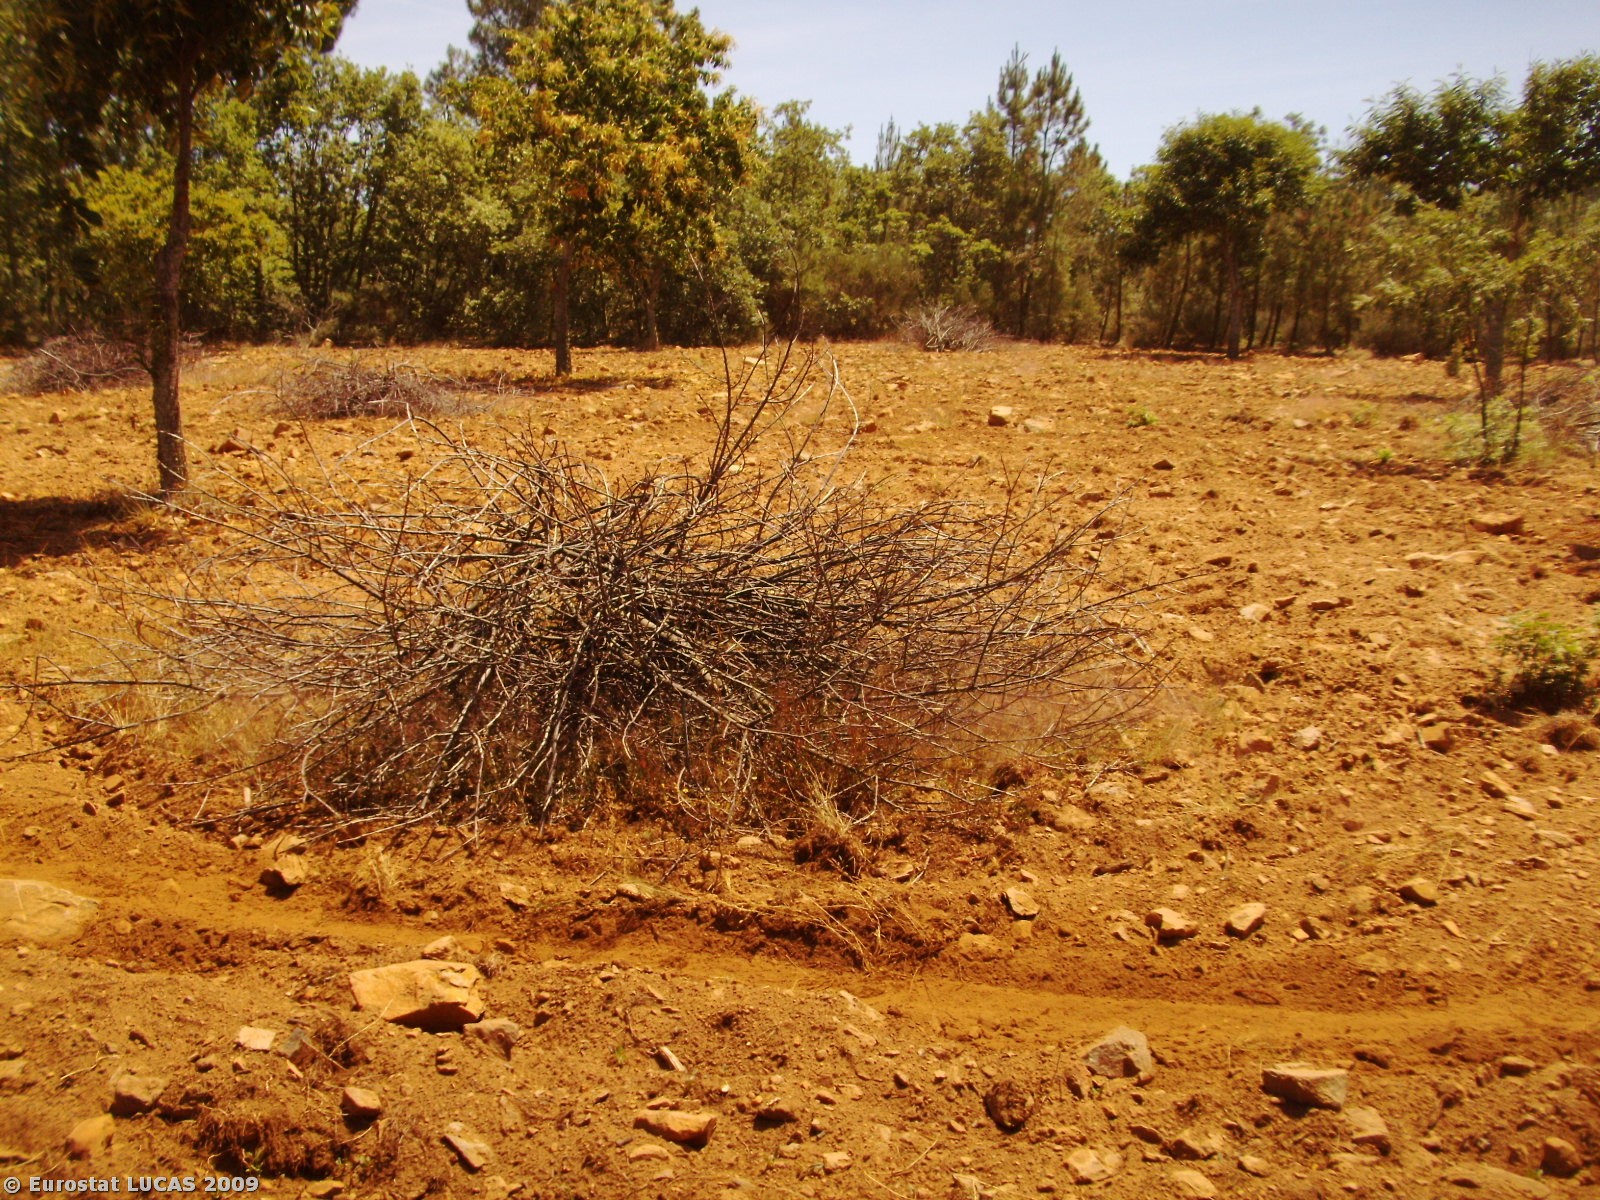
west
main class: Woodland
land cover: Mixed woodland
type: coniferous forest of the mediterranean region
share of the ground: > 75 %
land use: Forestry
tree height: > 5 m
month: July
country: PT
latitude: 40.3798
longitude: -6.9752
